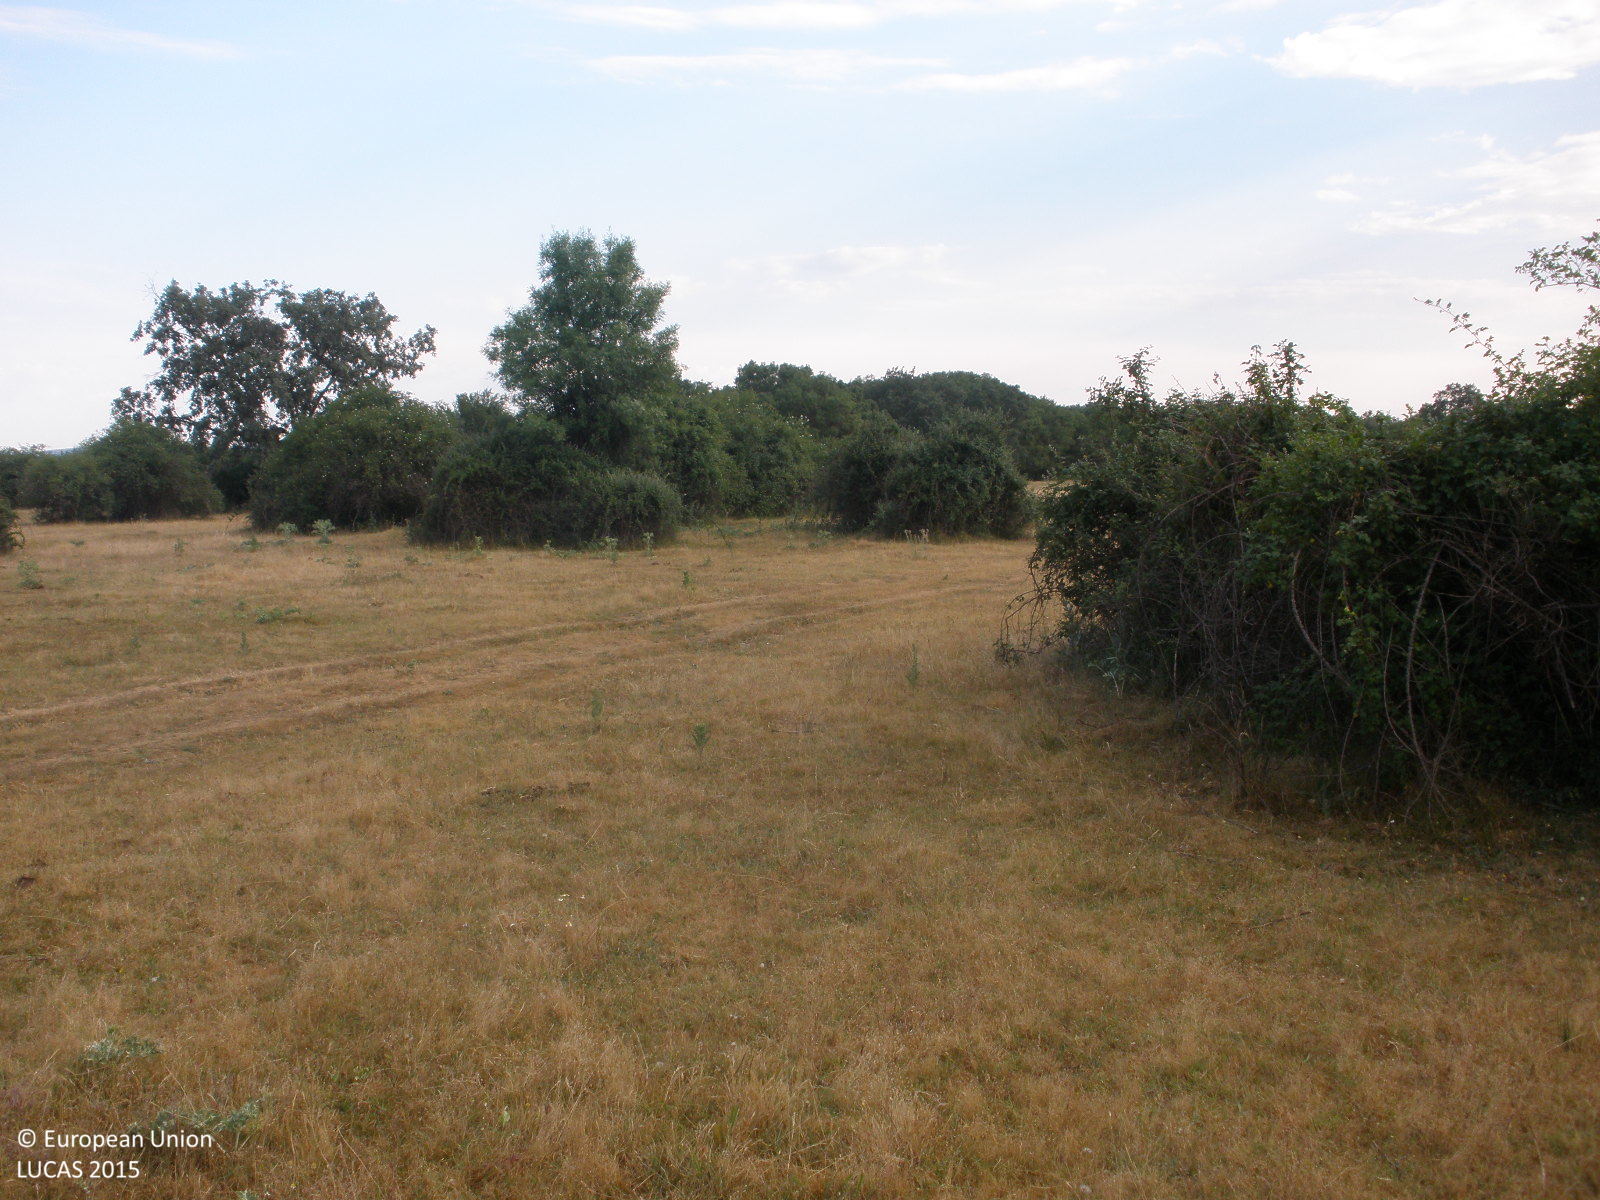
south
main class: Grassland
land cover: Grassland with sparse tree/shrub cover
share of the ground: > 75 %
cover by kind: herbaceous plants 85 %, shrubs 10 %, broadleaved forest trees 5 %
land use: Agriculture (excluding fallow land and kitchen gardens)
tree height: > 5 m
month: June
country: ES
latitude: 40.7097
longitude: -6.3391
